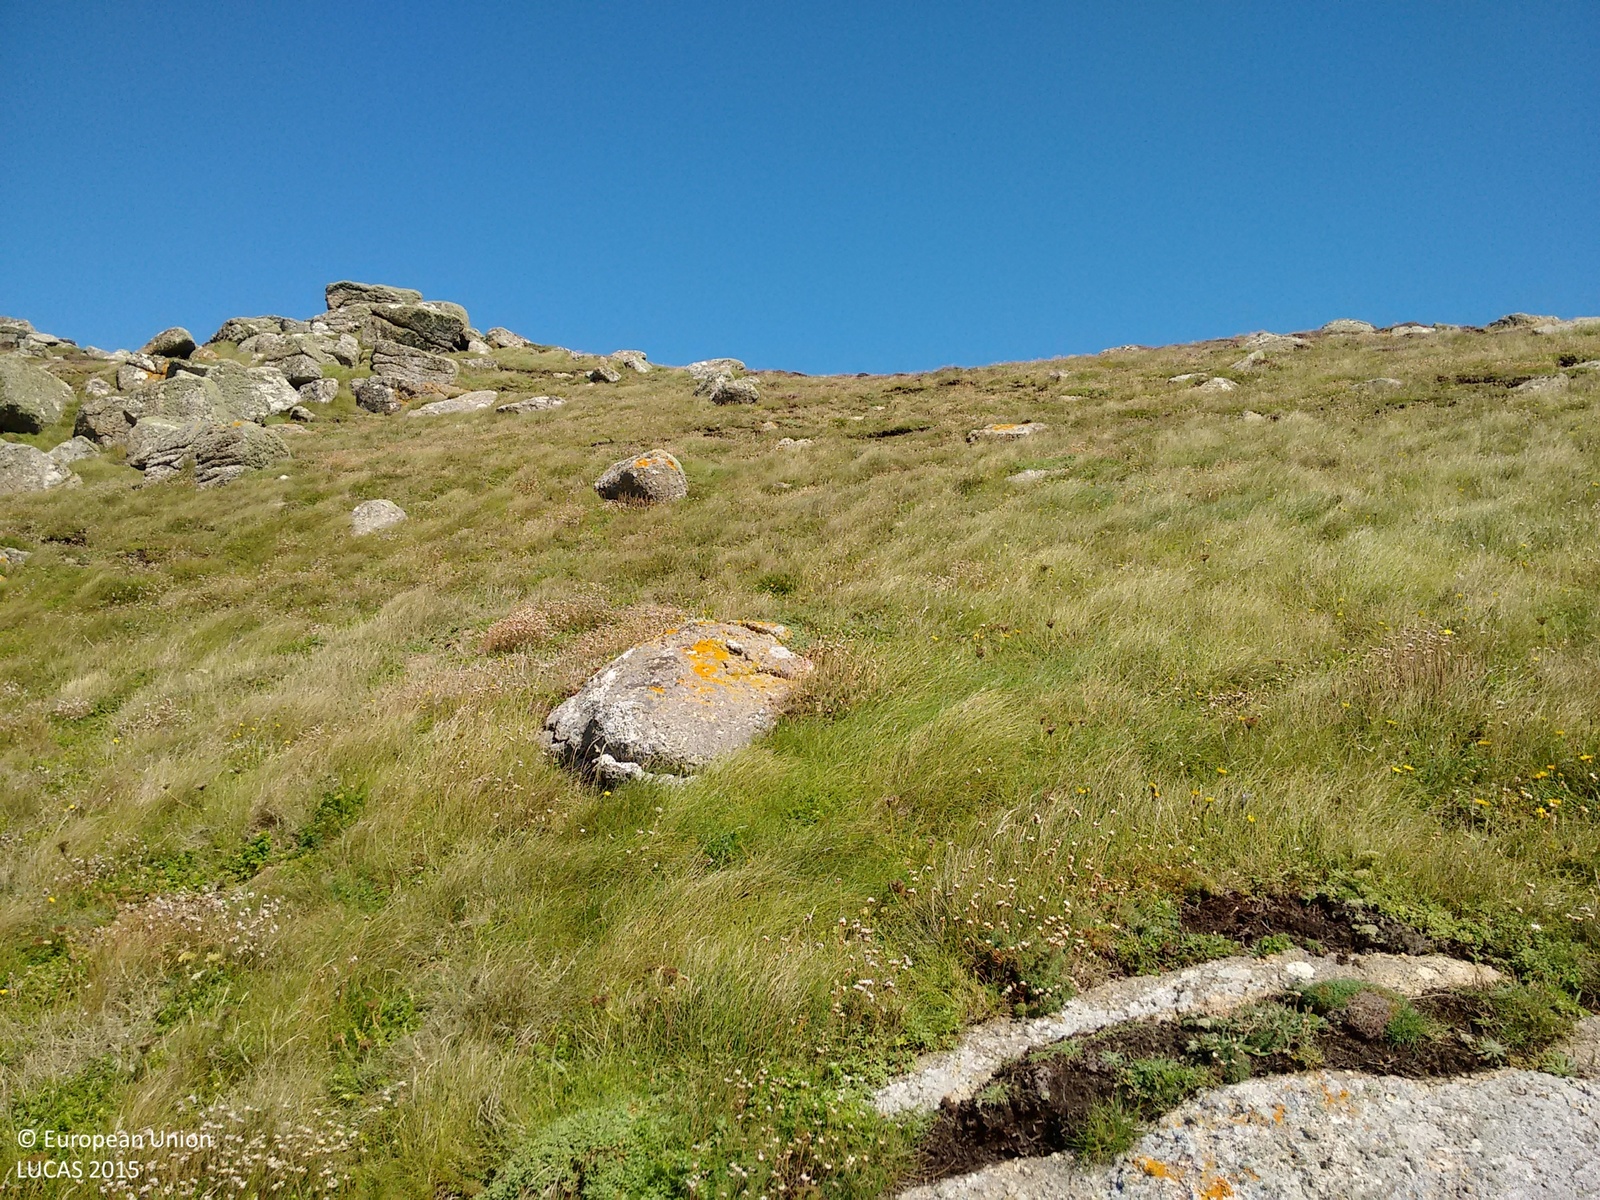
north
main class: Grassland
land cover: Grassland without tree/shrub cover
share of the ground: > 75 %
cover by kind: herbaceous plants 90 %, unconsolidated bare surface 10 %
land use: Agriculture (excluding fallow land and kitchen gardens)
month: August
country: GB
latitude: 50.0577
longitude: -5.7069
